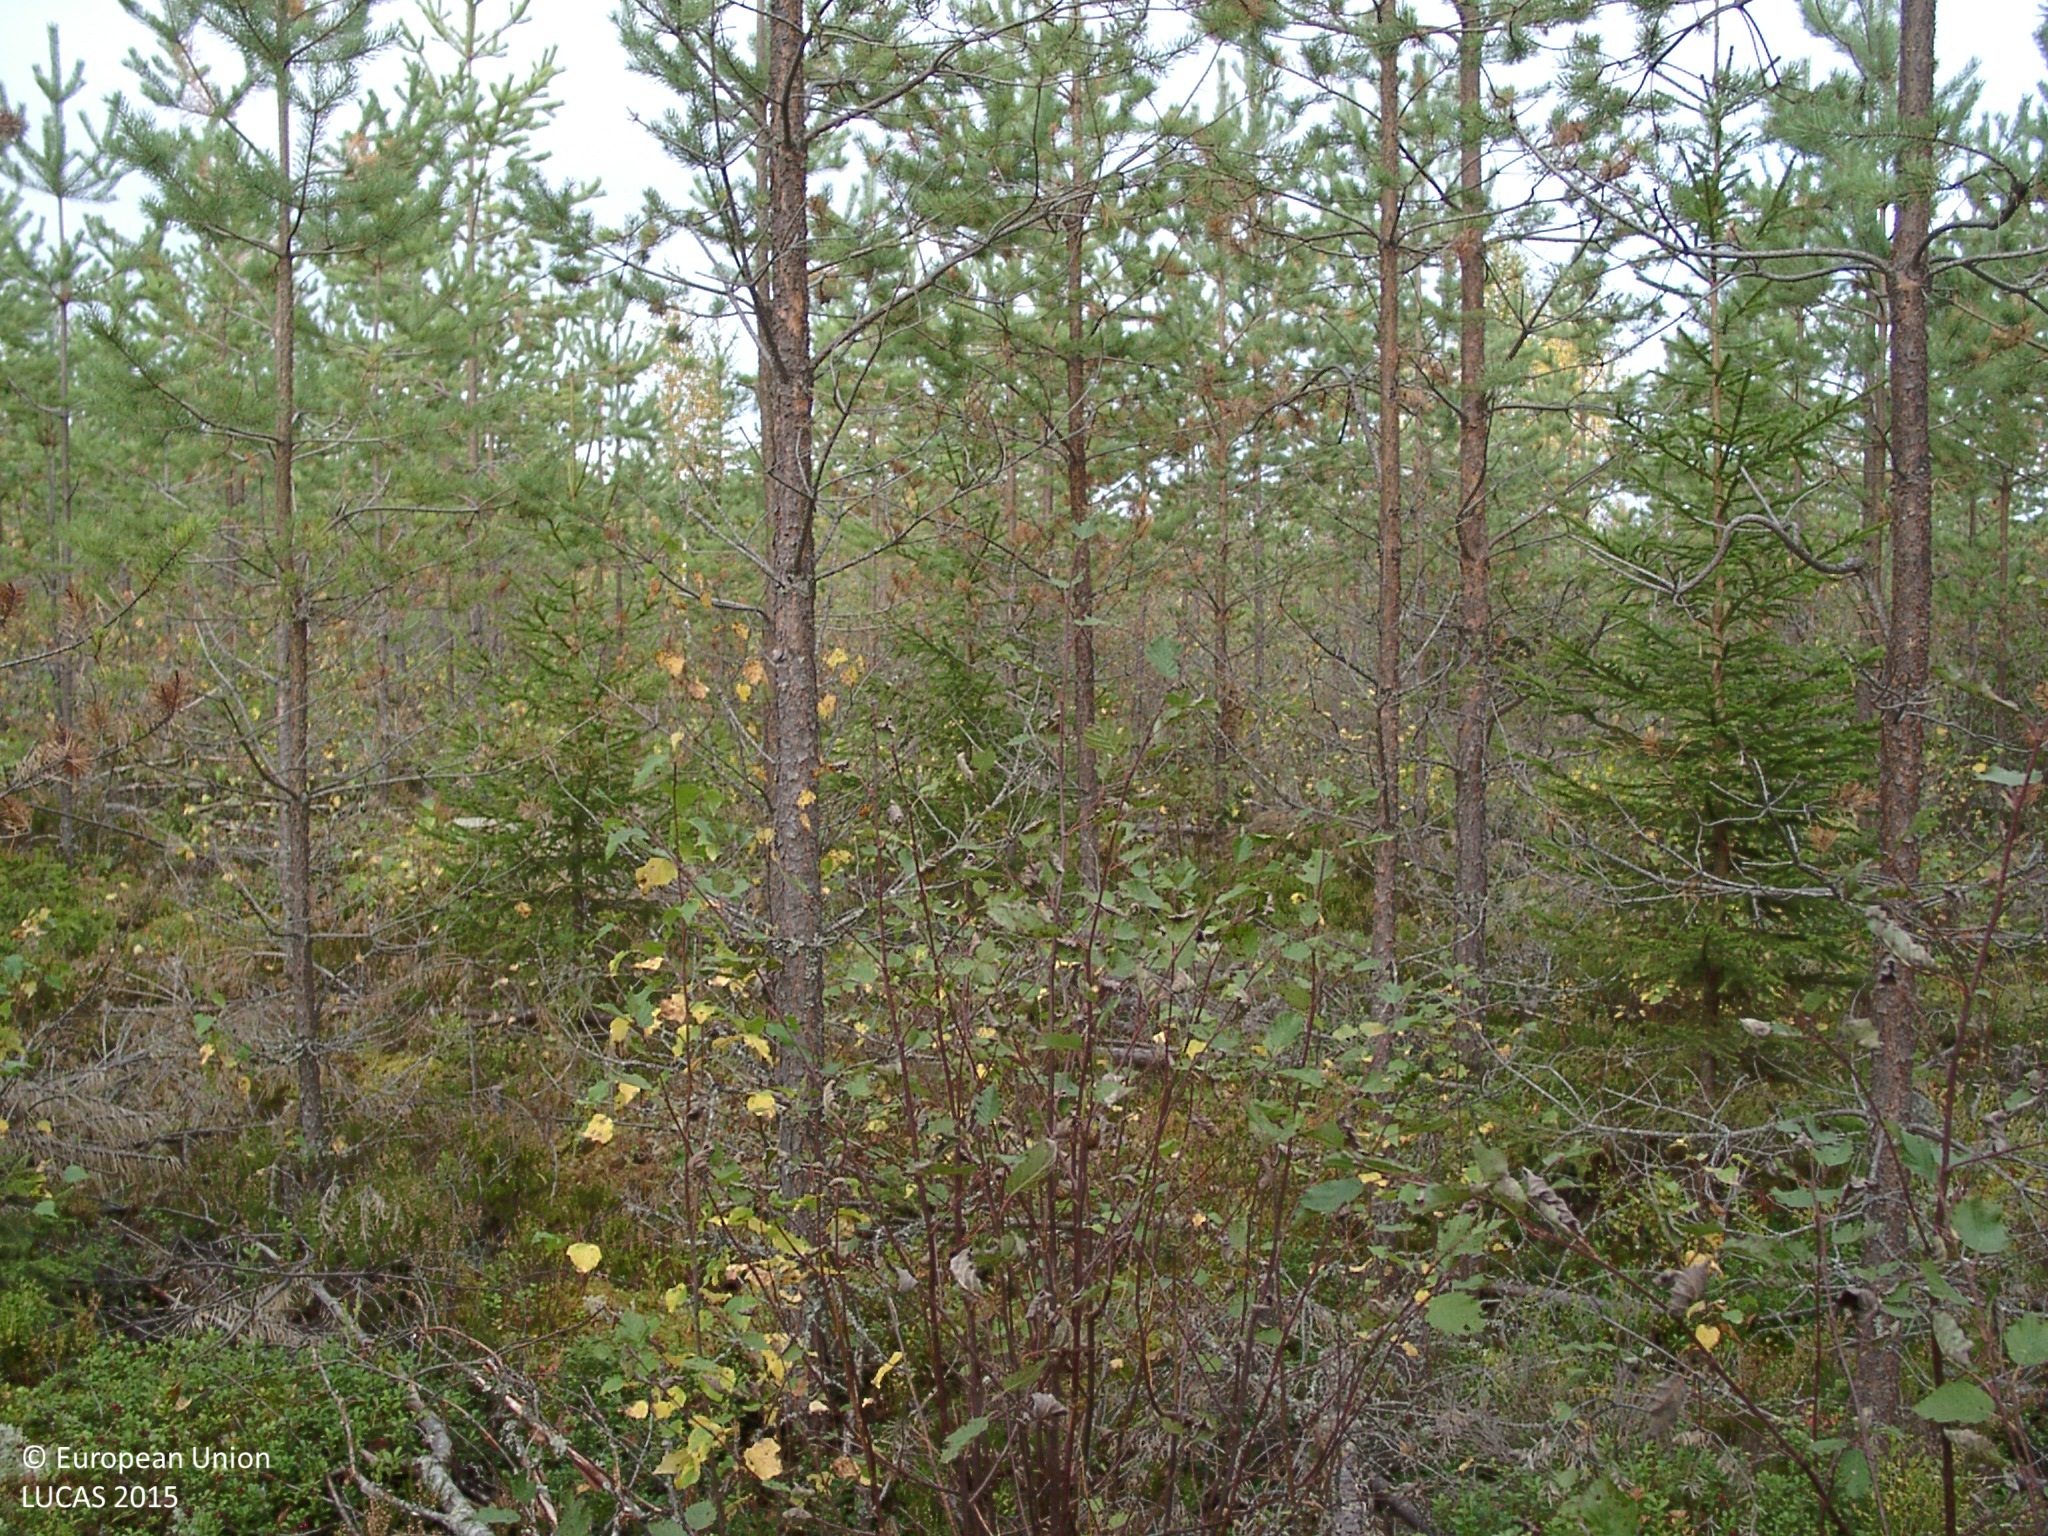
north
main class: Woodland
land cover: Pine dominated mixed woodland
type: boreal forest
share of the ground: 50 - 75 %
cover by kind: coniferous forest trees 45 %, shrubs 20 %, lichens and mosses 20 %, broadleaved forest trees 15 %
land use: Forestry
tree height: < 5 m
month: September
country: FI
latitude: 62.6759
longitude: 25.4377
